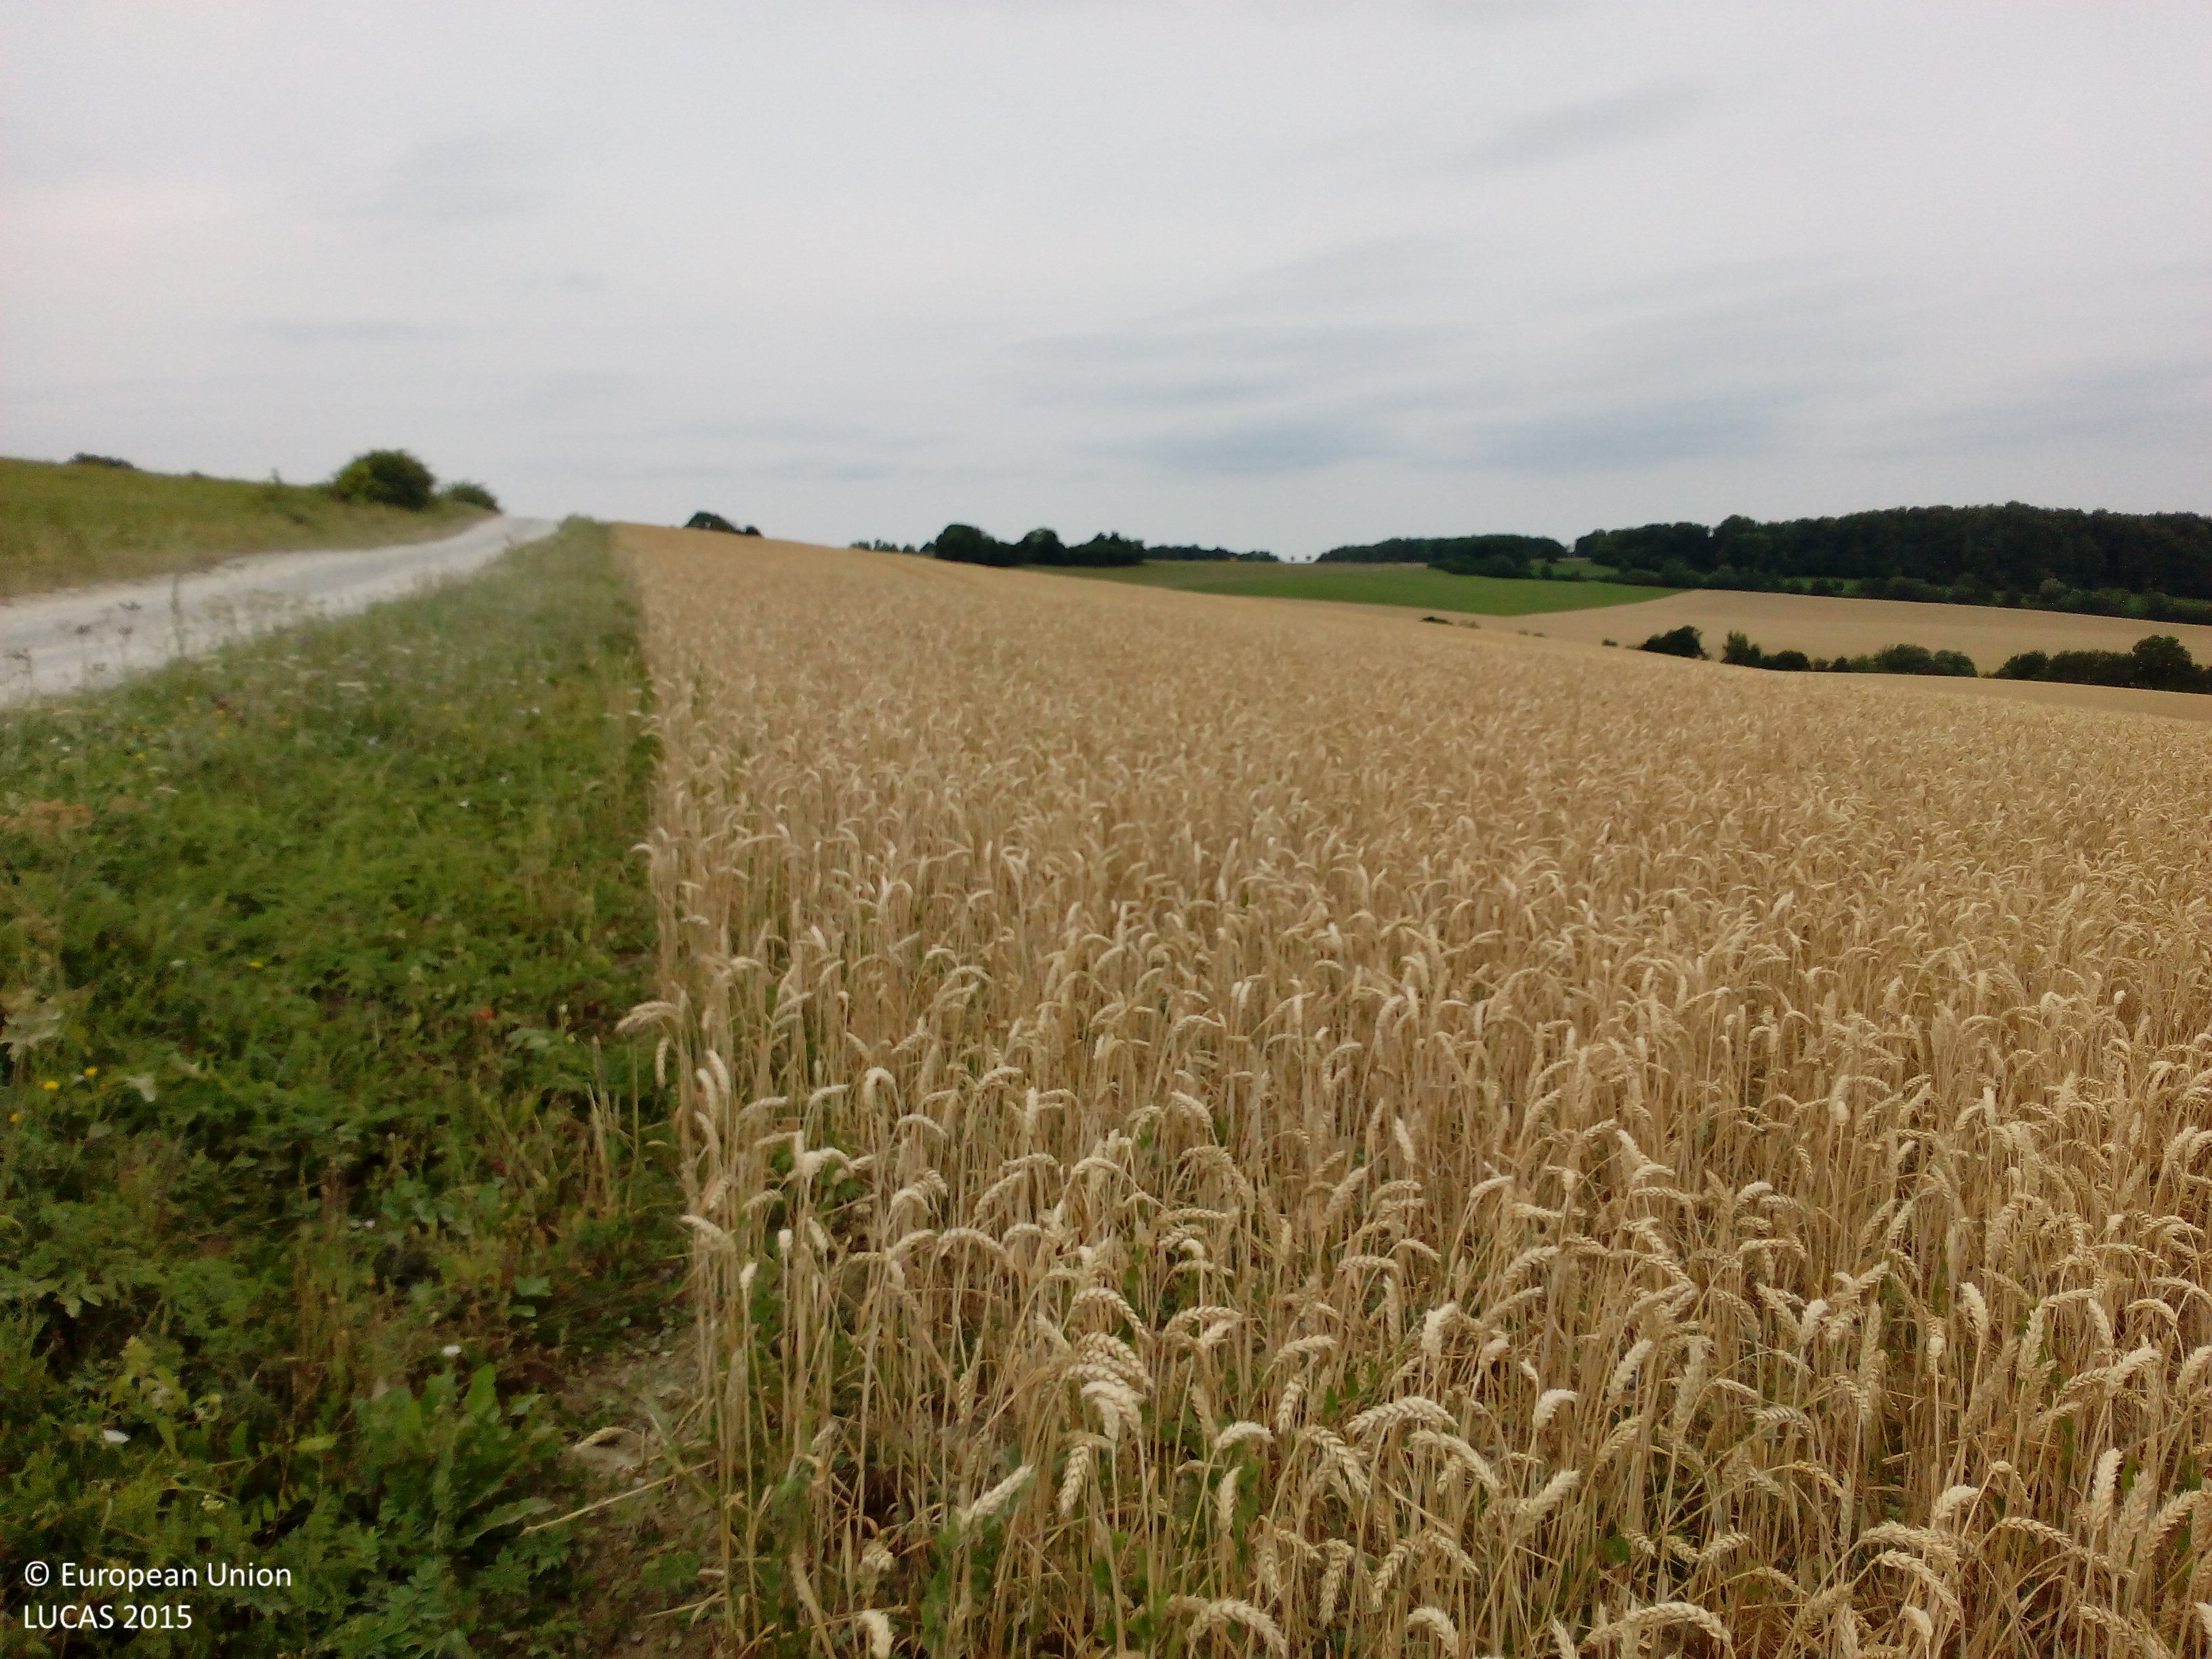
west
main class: Cropland
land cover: Common wheat
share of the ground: > 75 %
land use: Agriculture (excluding fallow land and kitchen gardens)
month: August
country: DE
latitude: 51.2447
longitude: 10.2721
